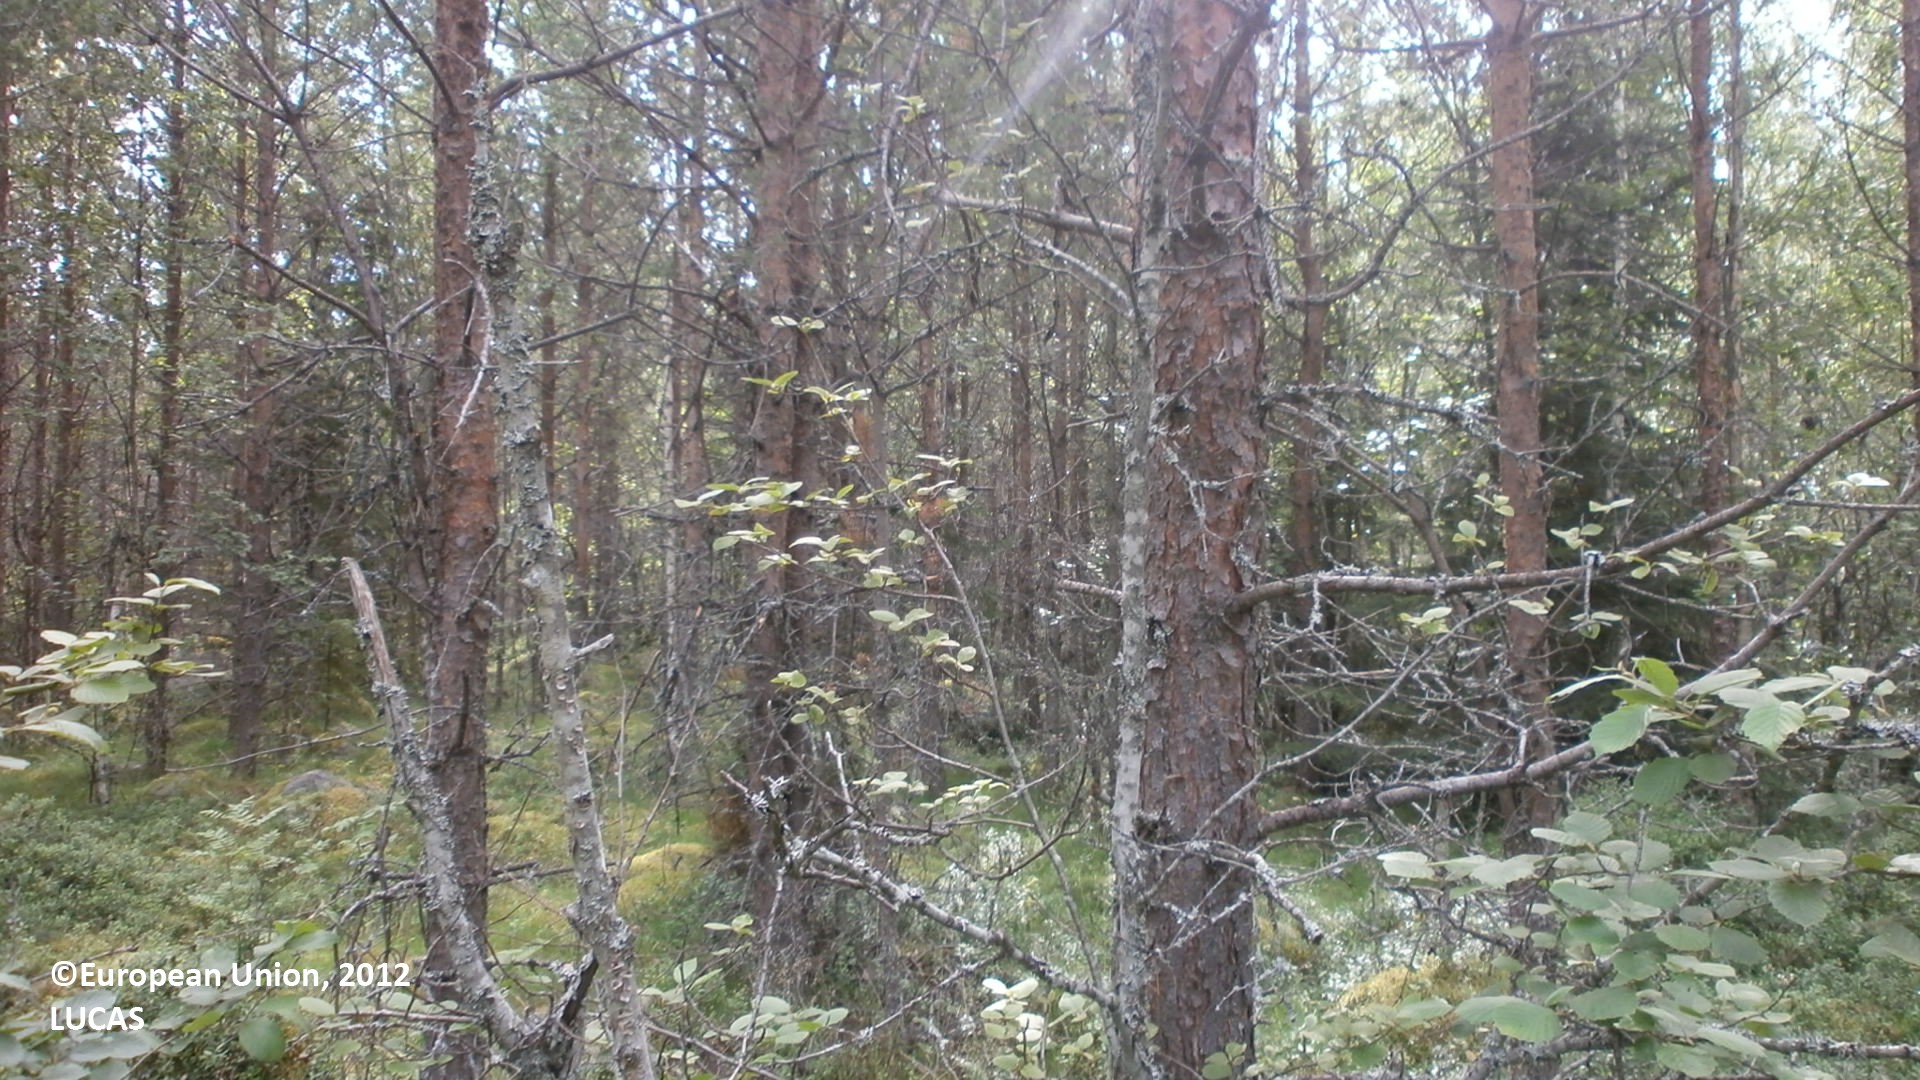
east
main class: Woodland
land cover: Pine dominated coniferous woodland
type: boreal forest
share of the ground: 50 - 75 %
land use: Forestry
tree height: > 5 m
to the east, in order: Pine dominated coniferous woodland; Rocks and stones; Pine dominated coniferous woodland; Pine dominated mixed woodland
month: July
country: FI
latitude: 64.0556
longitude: 23.9330
